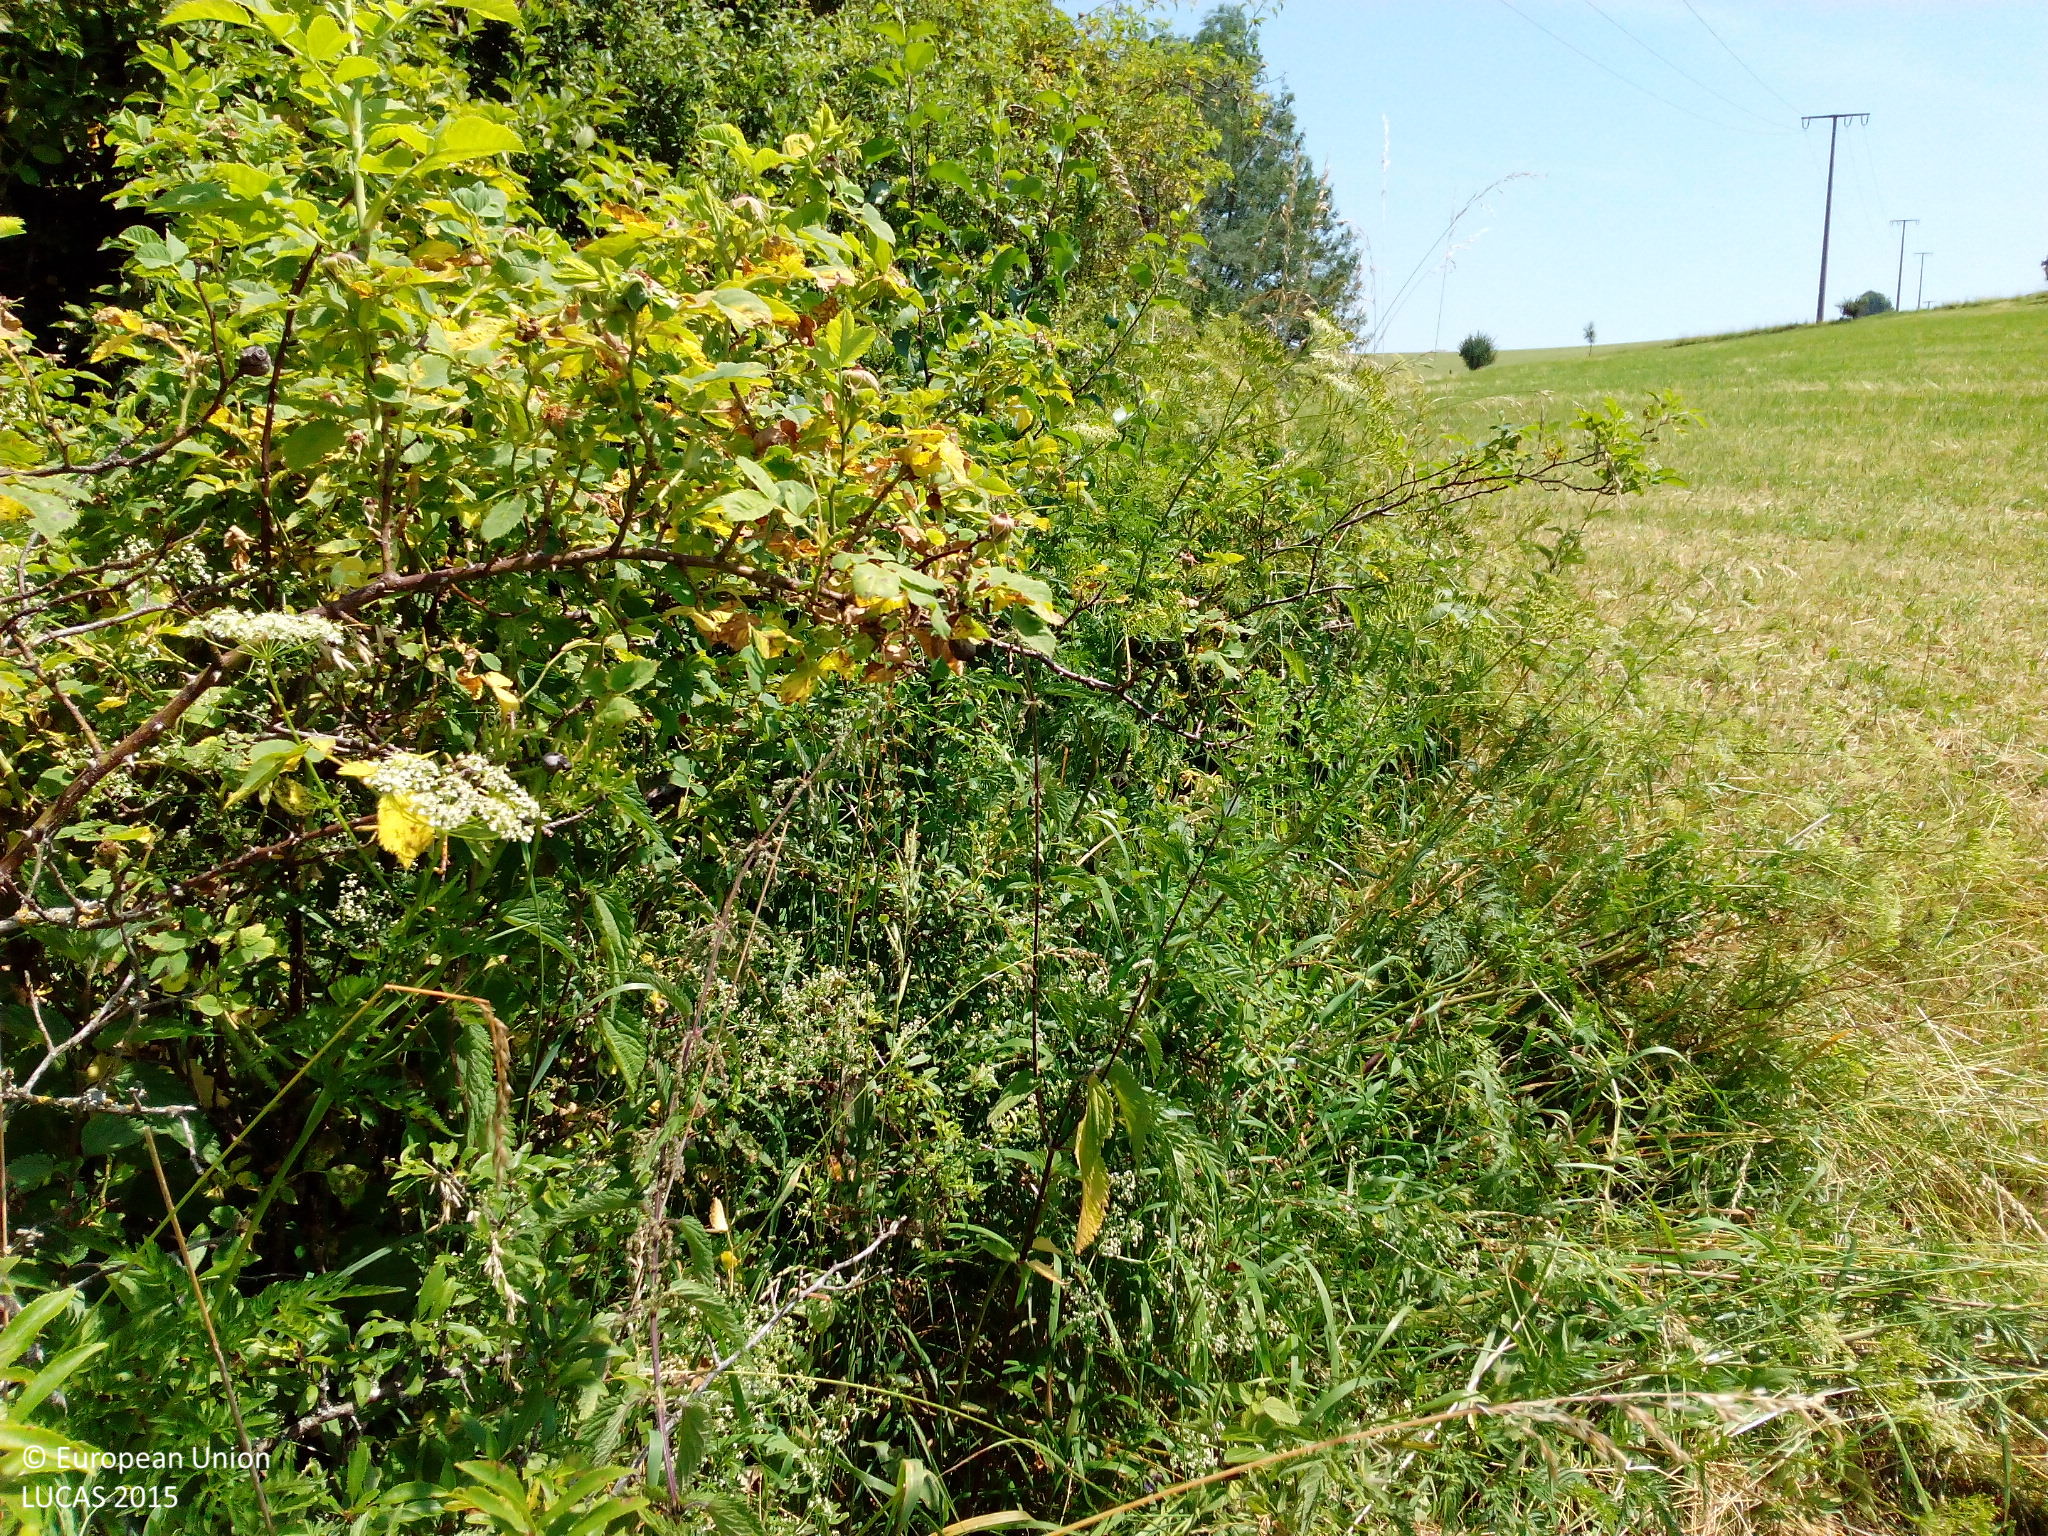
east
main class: Shrubland
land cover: Shrubland with sparse tree cover
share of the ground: 50 - 75 %
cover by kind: shrubs 70 %, herbaceous plants 25 %, broadleaved forest trees 5 %
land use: Agriculture (excluding fallow land and kitchen gardens)
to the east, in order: Shrubland with sparse tree cover; Grassland without tree/shrub cover; Electric lines; Grassland without tree/shrub cover; Shrubland with sparse tree cover; Grassland without tree/shrub cover; Groves; Broadleaved woodland; Shrubland with sparse tree cover; Shruby margins; Grassland without tree/shrub cover
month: July
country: DE
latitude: 48.4378
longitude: 9.3921
